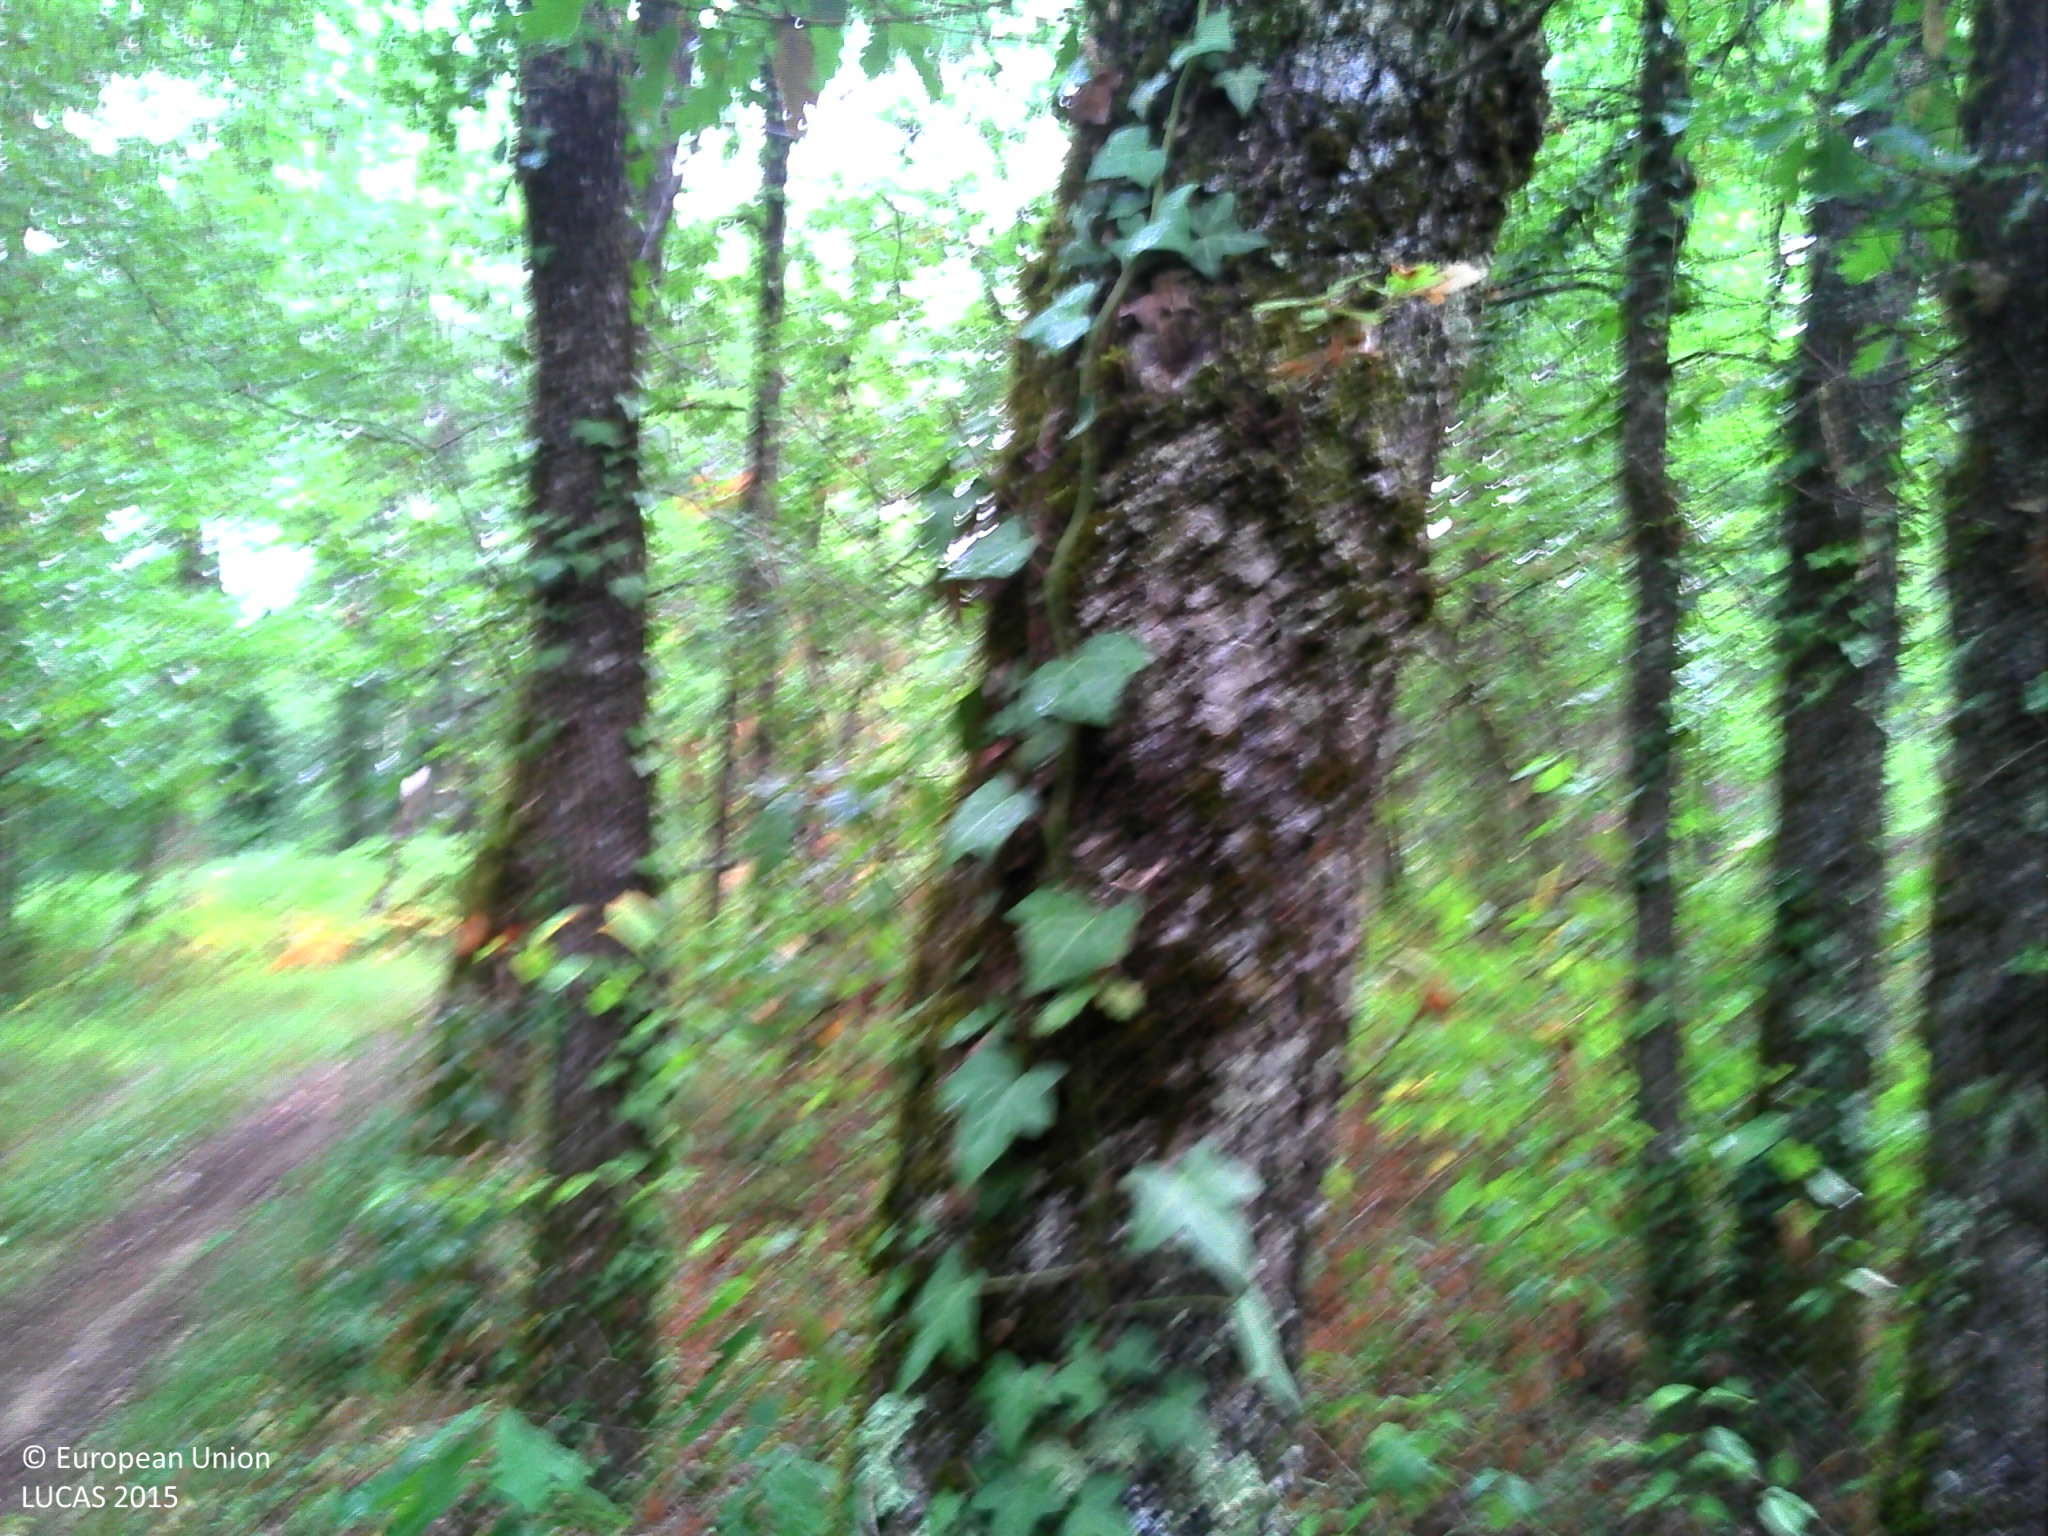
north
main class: Woodland
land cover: Broadleaved woodland
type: thermophilous deciduous forest
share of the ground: > 75 %
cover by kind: broadleaved forest trees 80 %, herbaceous plants 10 %, shrubs 5 %, lichens and mosses 5 %
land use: Forestry
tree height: > 5 m
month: August
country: FR
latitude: 44.6353
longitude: 0.8544
